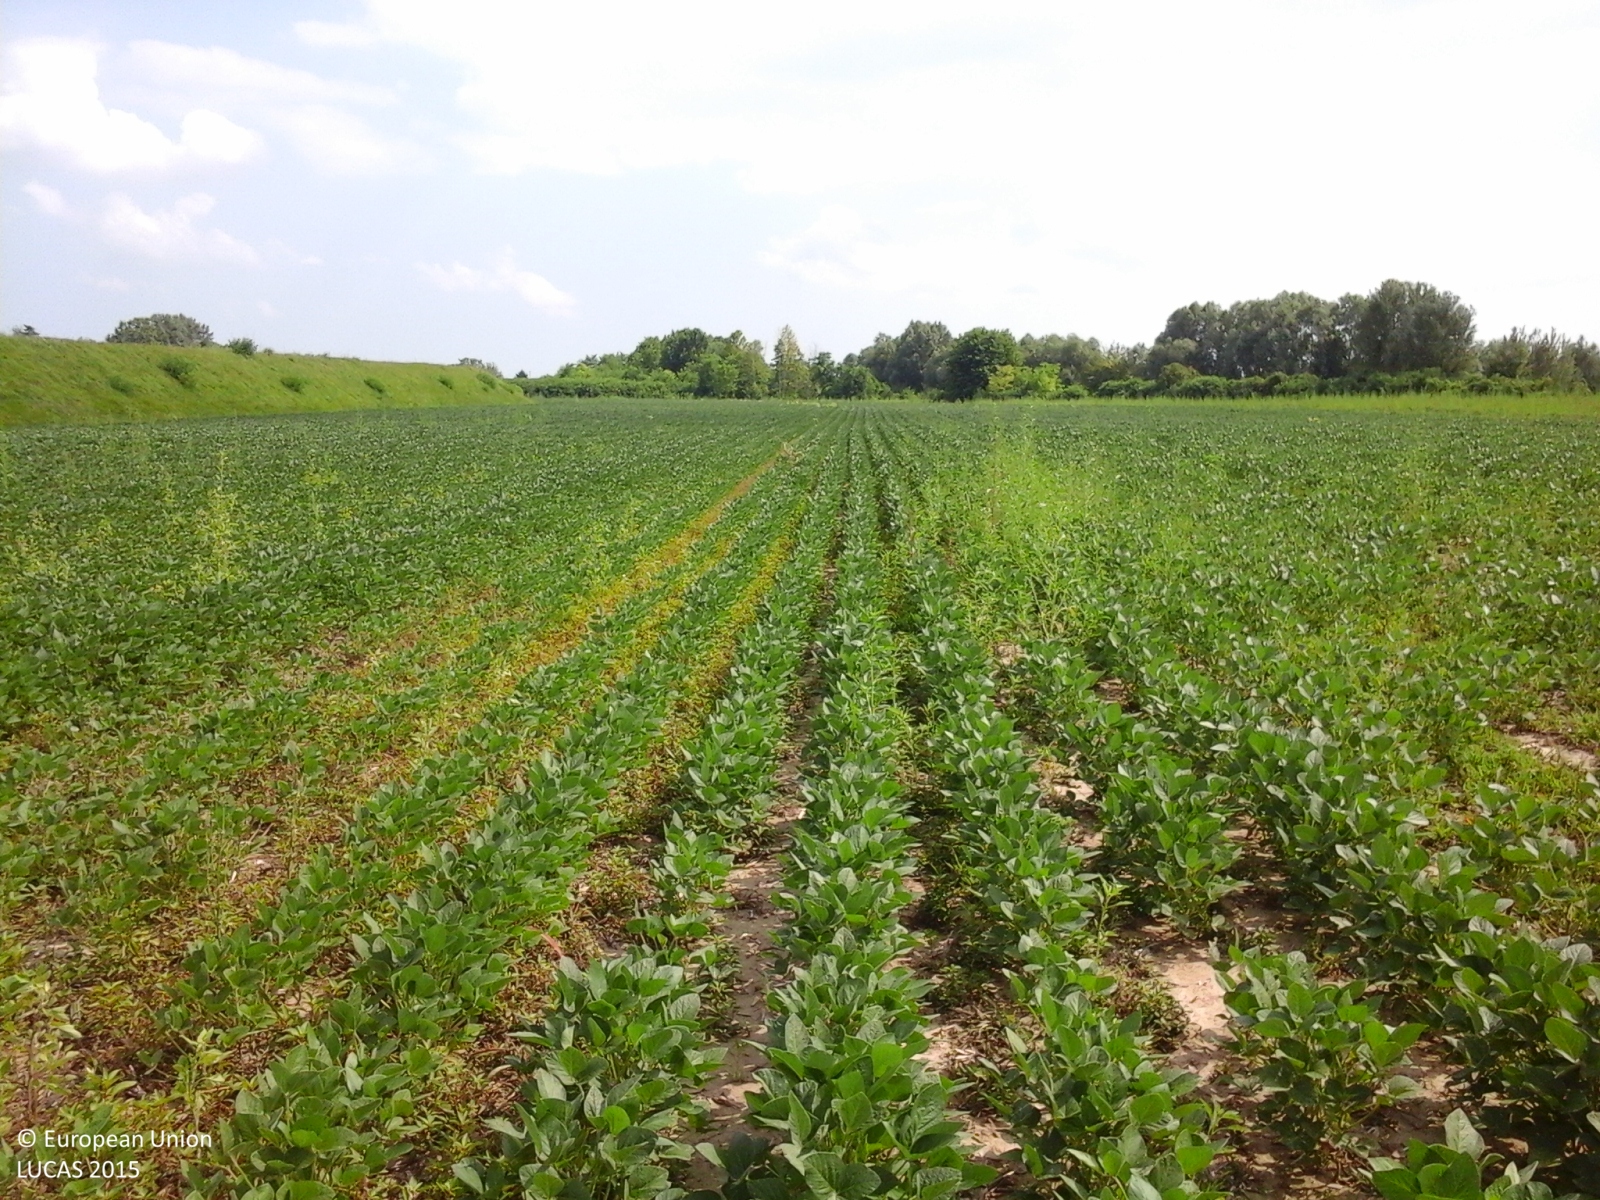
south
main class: Cropland
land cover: Soya
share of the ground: < 10 %
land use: Agriculture (excluding fallow land and kitchen gardens)
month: June
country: IT
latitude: 45.7961
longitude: 12.6338
